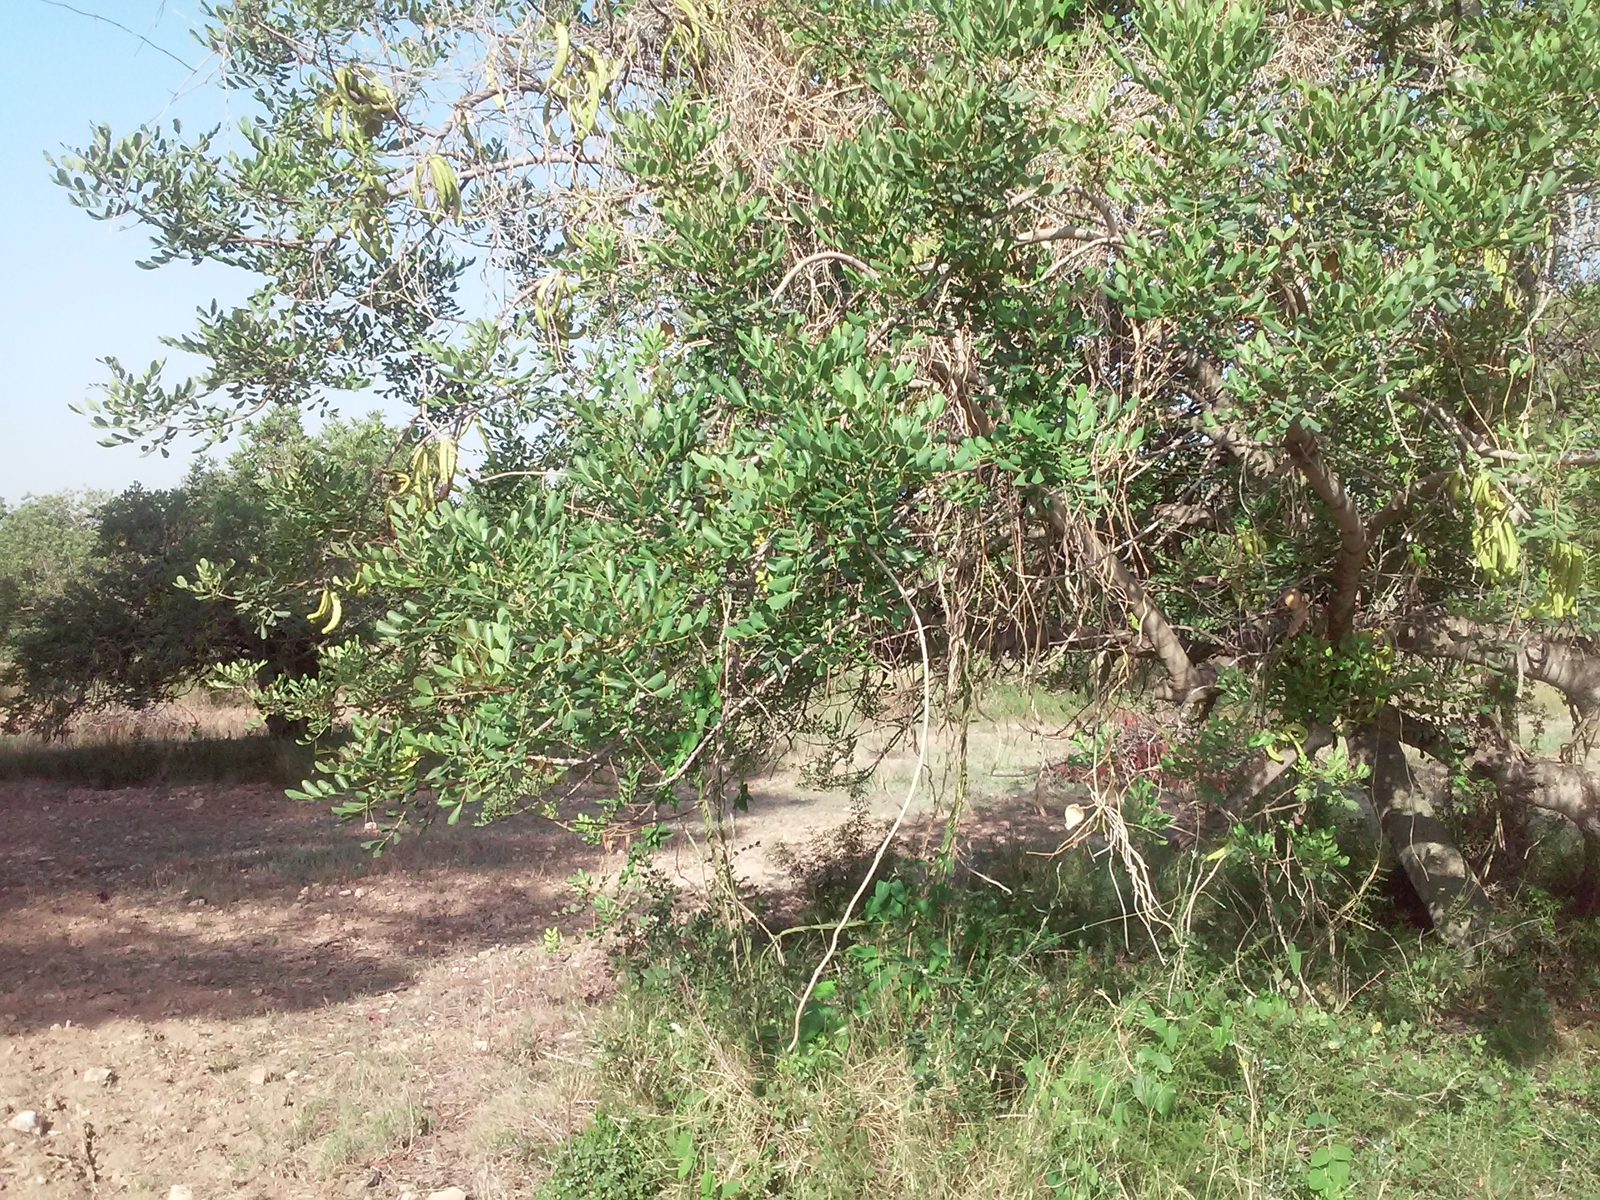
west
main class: Cropland
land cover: Permanent industrial crops
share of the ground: 10 - 25 %
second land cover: Other bare soil
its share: > 75 %
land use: Agriculture (excluding fallow land and kitchen gardens)
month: July
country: ES
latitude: 41.2212
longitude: 1.2496
